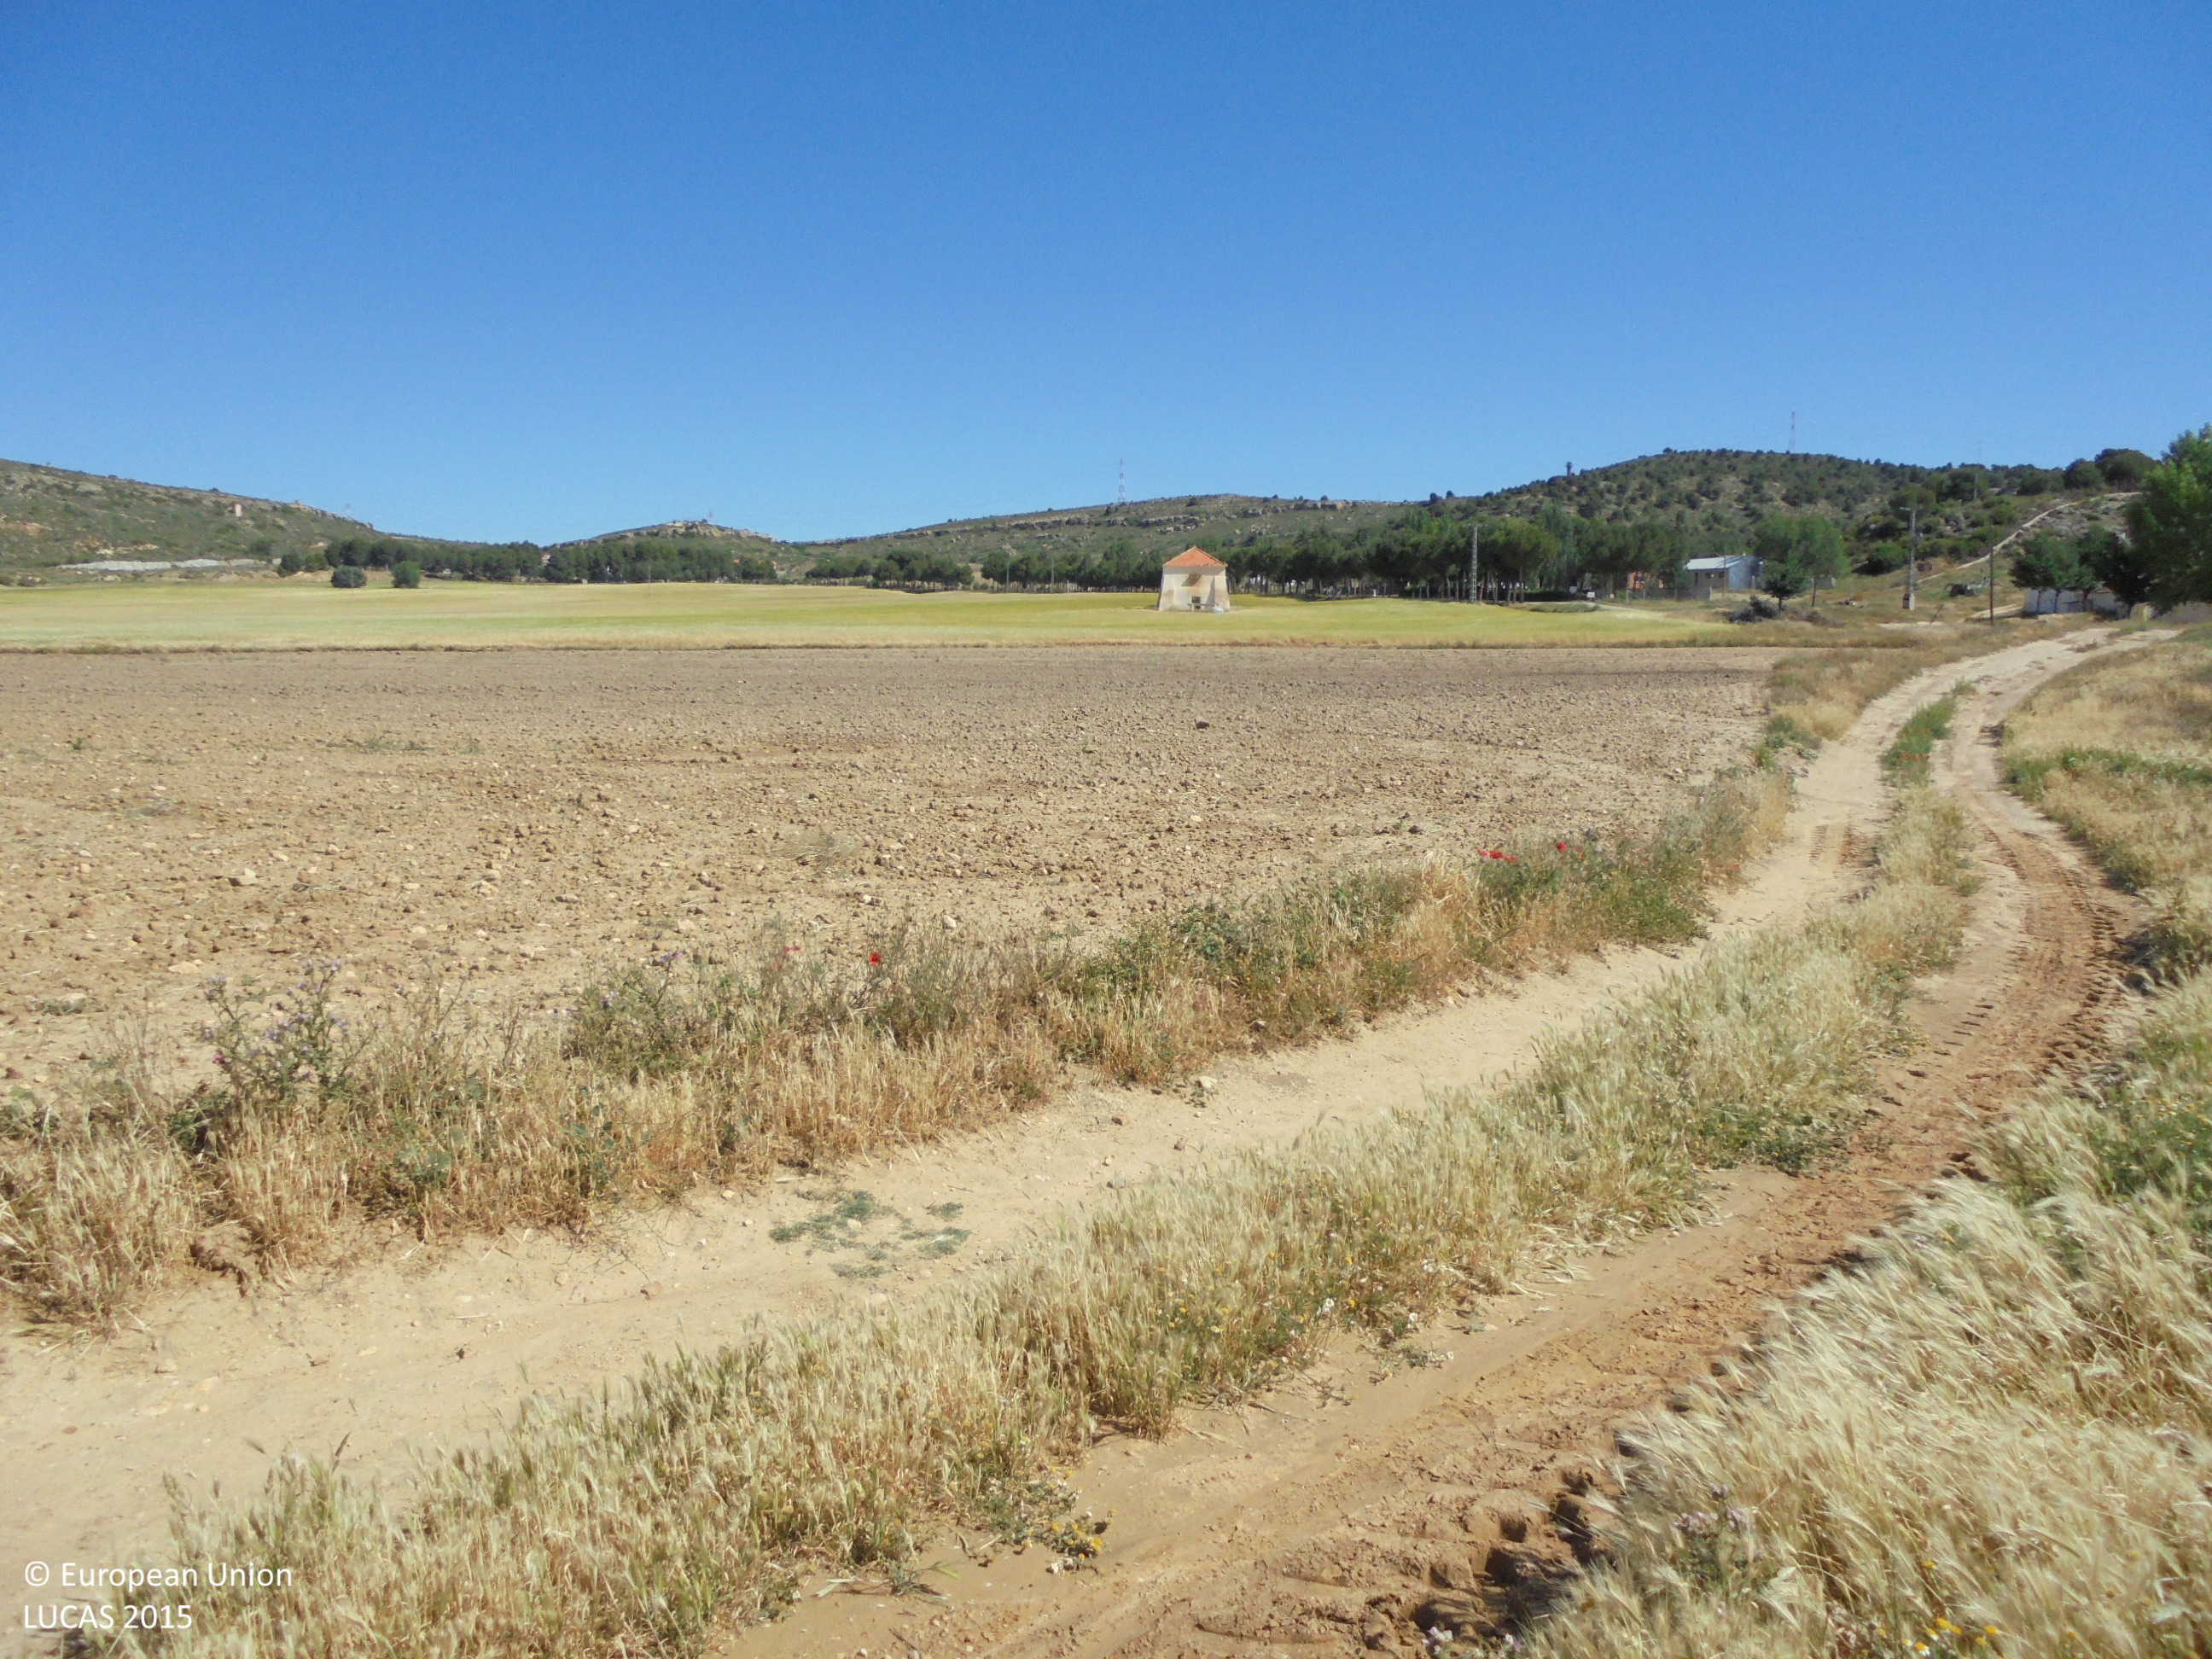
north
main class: Grassland
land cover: Grassland without tree/shrub cover
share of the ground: > 75 %
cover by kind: herbaceous plants 95 %, unconsolidated bare surface 5 %
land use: Abandoned areas
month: May
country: ES
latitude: 38.9300
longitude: -1.6605
